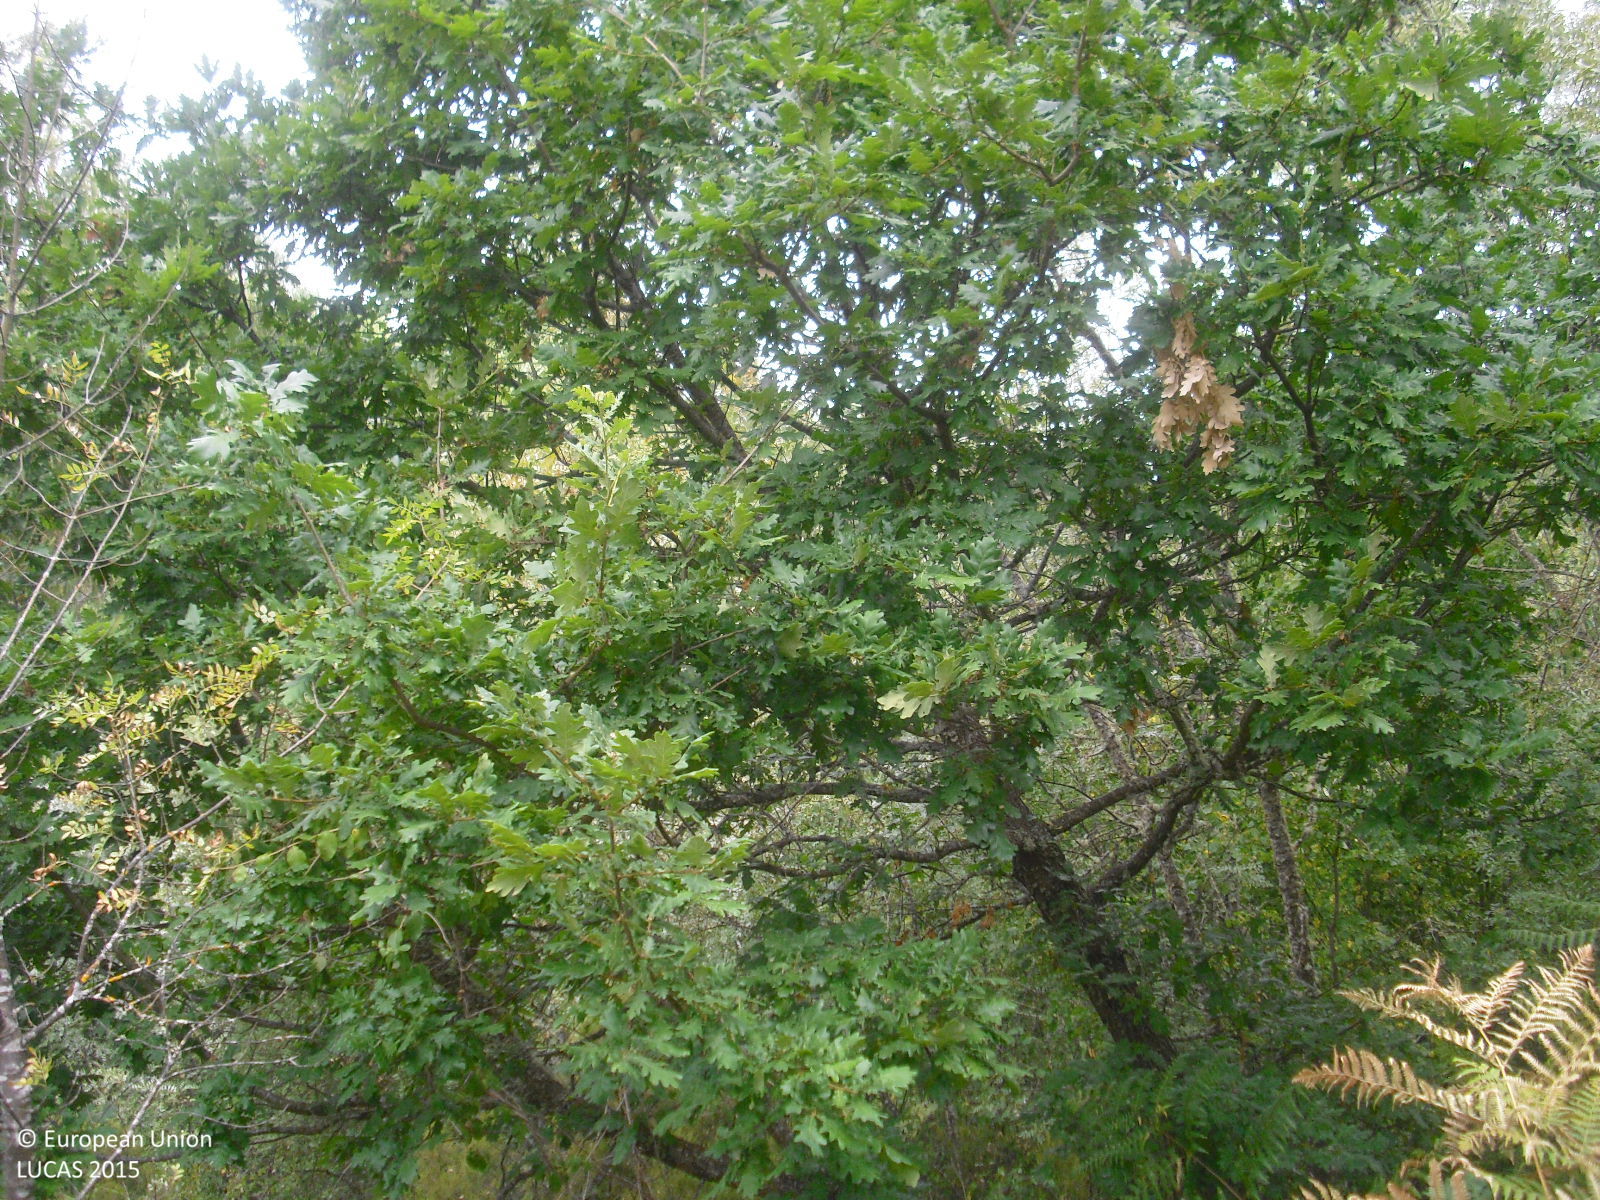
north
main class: Woodland
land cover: Broadleaved woodland
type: thermophilous deciduous forest
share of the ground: 50 - 75 %
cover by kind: broadleaved forest trees 60 %, shrubs 20 %, herbaceous plants 20 %
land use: Semi-natural and natural areas not in use
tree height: > 5 m
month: July
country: ES
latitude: 42.3992
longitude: -7.2271
